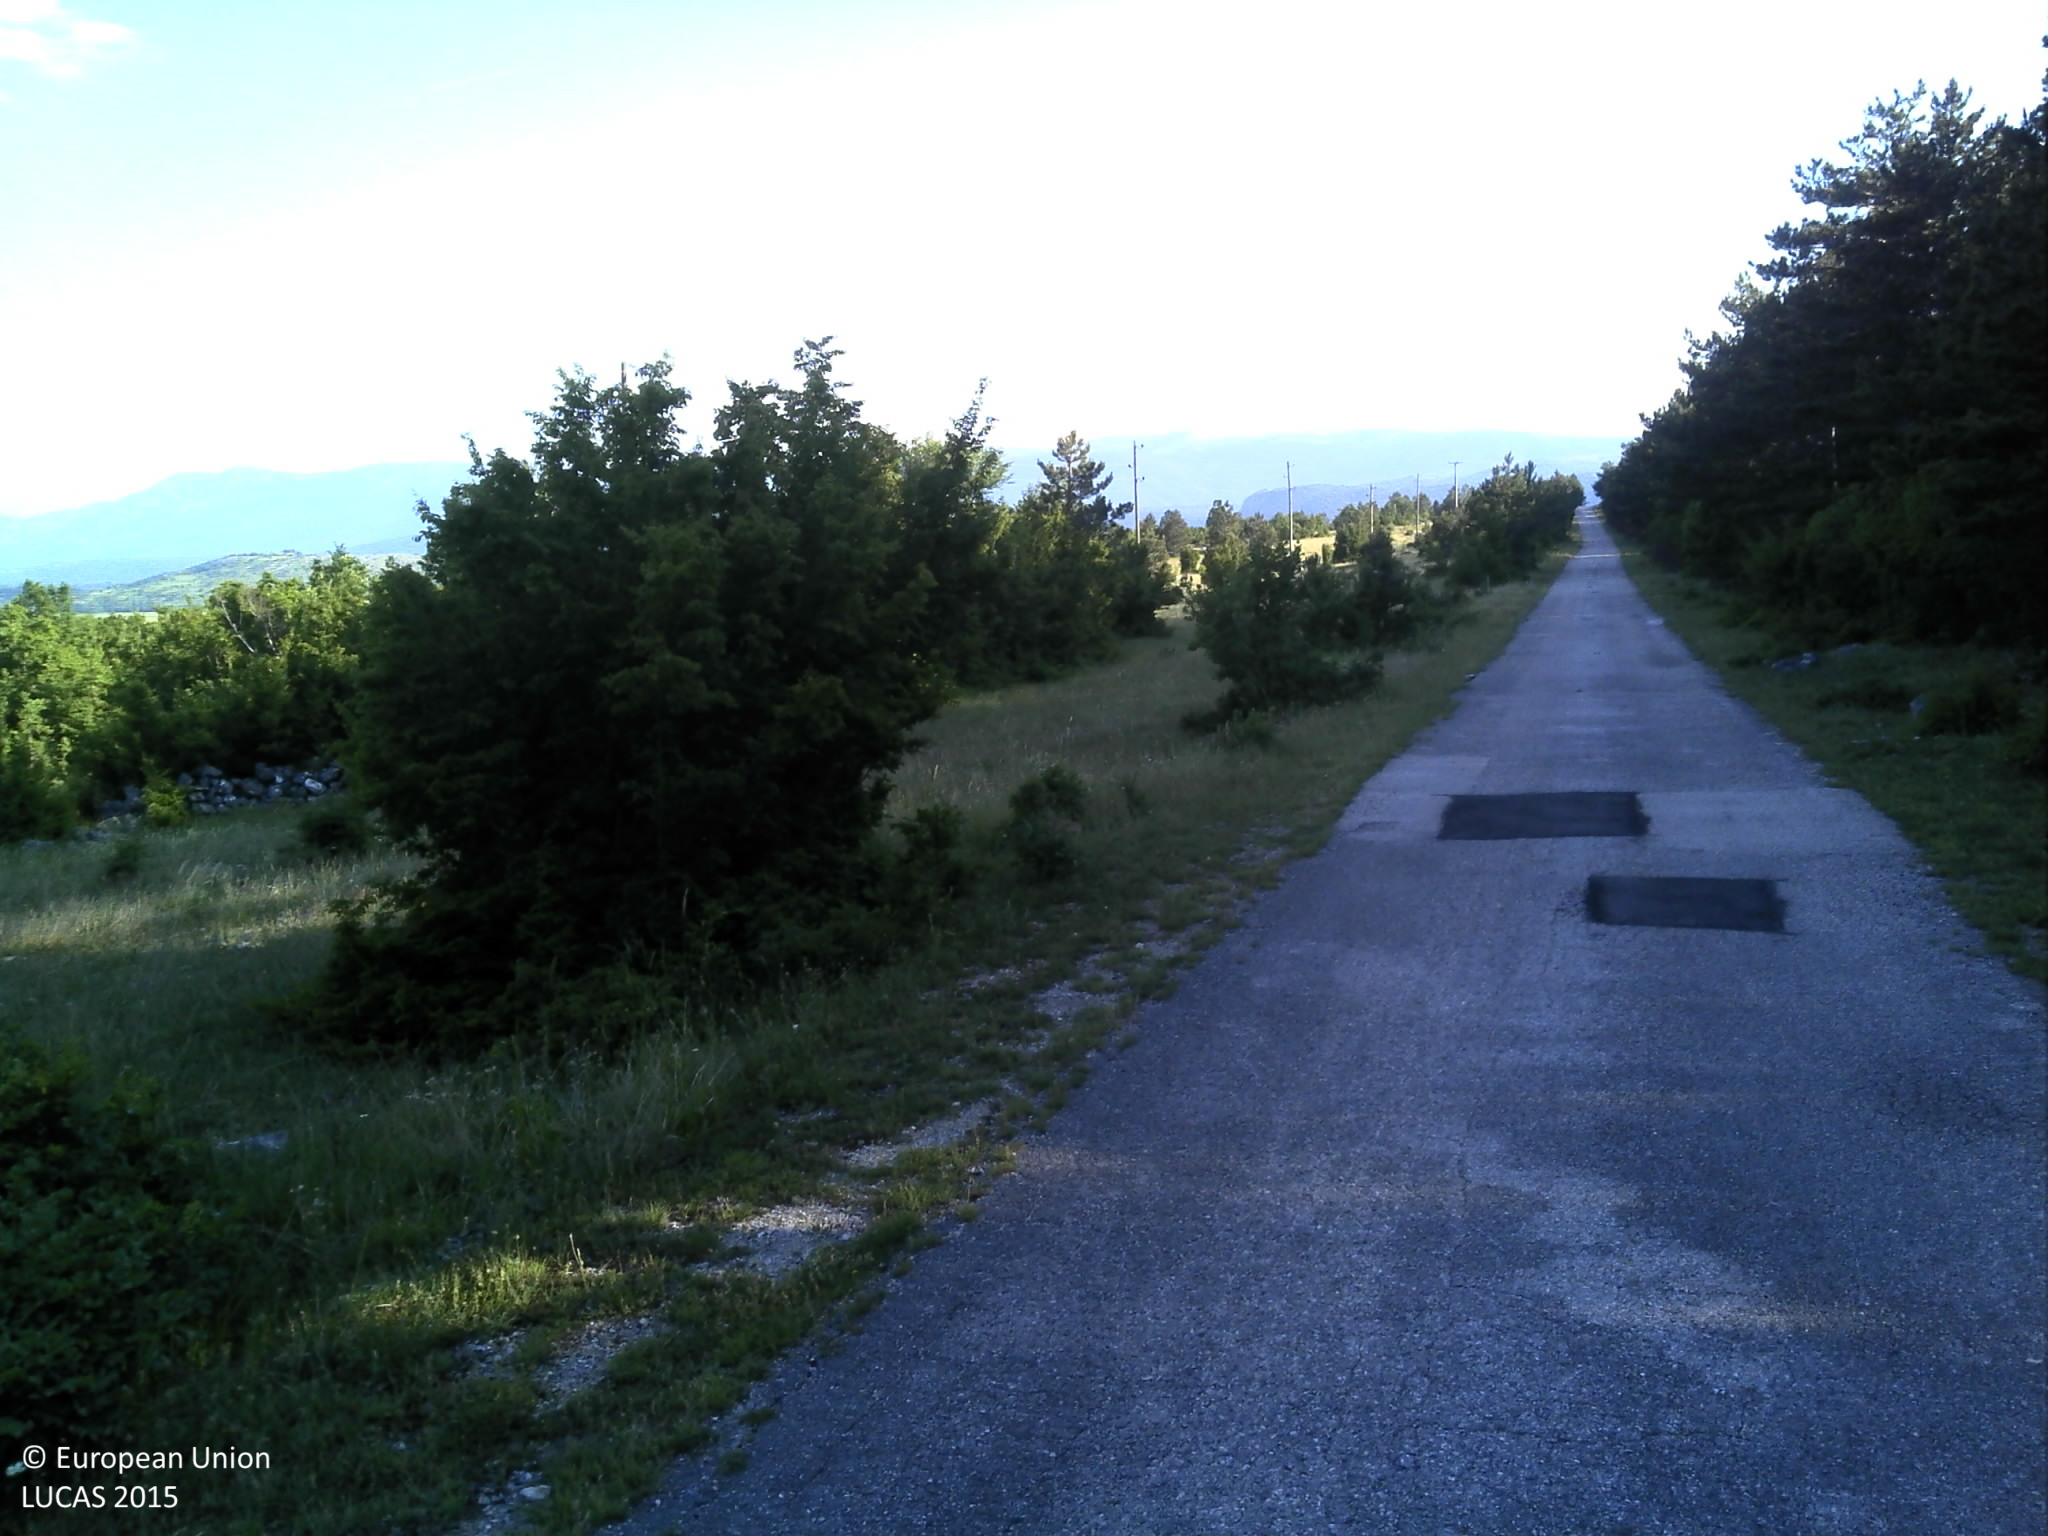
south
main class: Woodland
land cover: Pine dominated coniferous woodland
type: coniferous forest of the mediterranean region
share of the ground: > 75 %
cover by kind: coniferous forest trees 90 %, shrubs 5 %, herbaceous plants 5 %
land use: Forestry
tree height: > 5 m
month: June
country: HR
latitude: 43.9713
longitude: 16.4120
